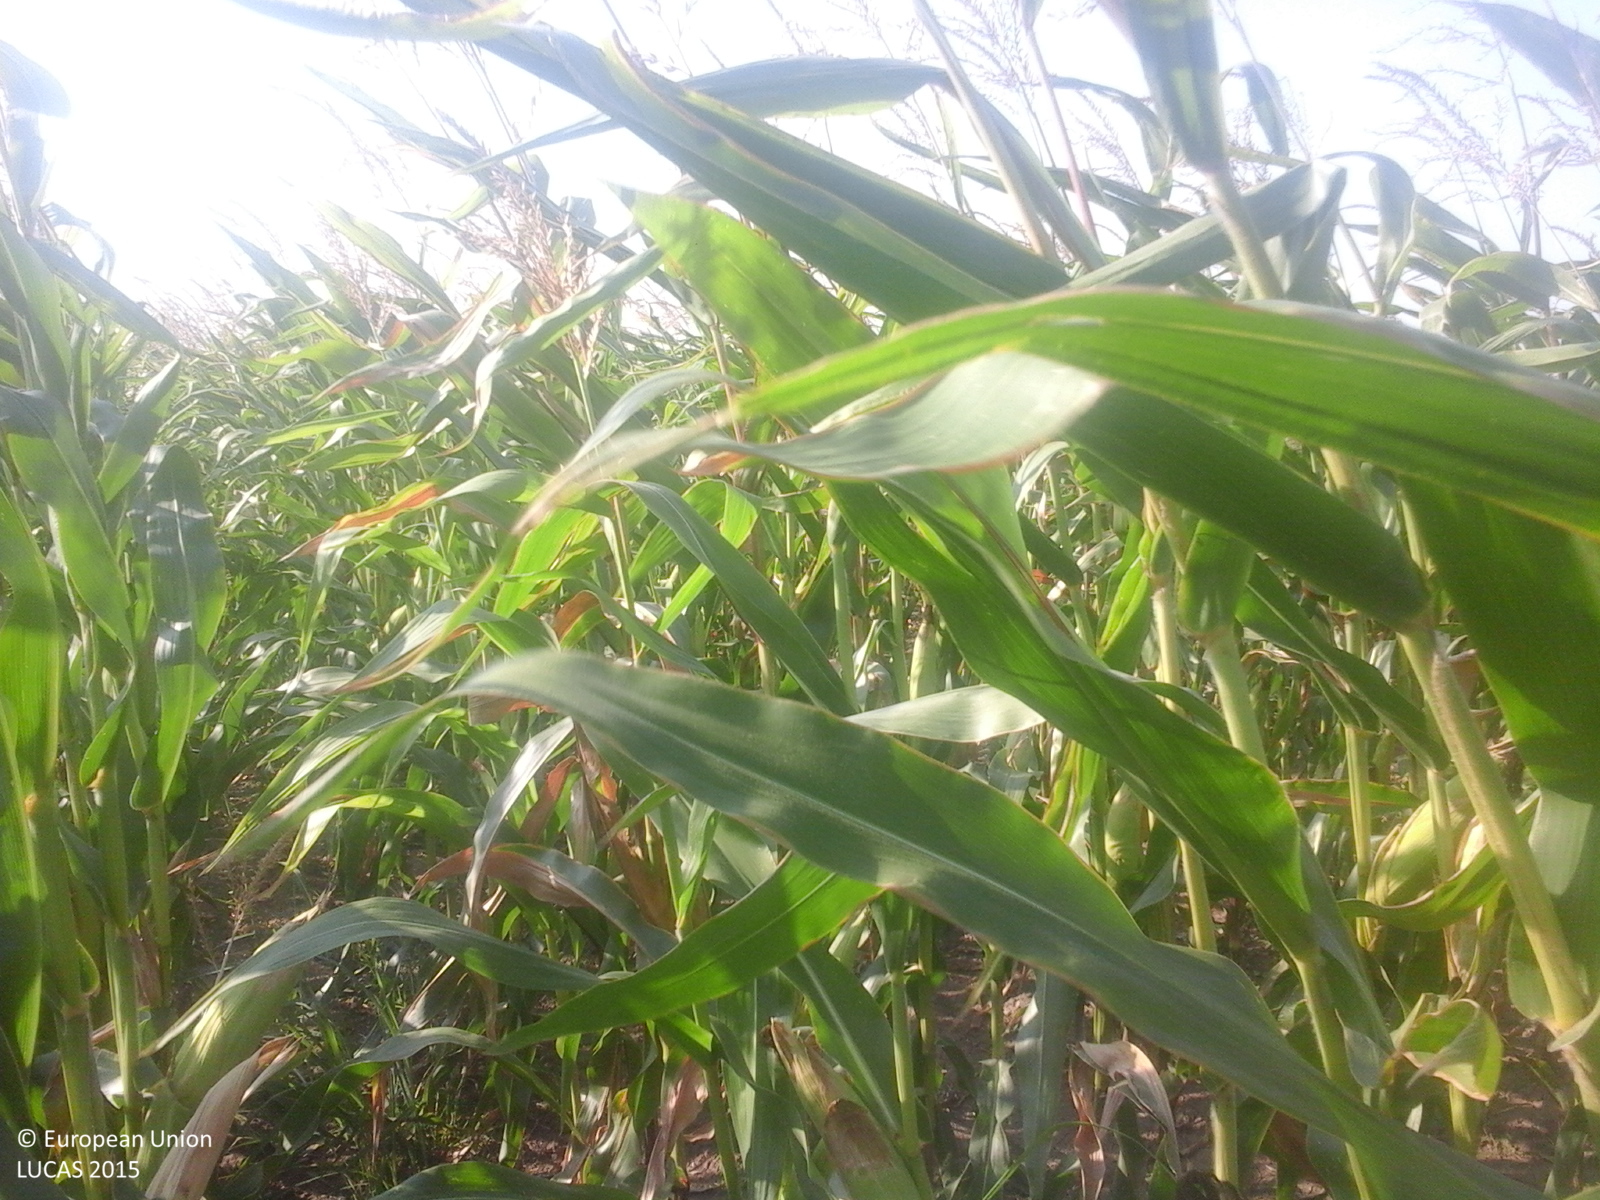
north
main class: Cropland
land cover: Maize
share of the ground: > 75 %
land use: Agriculture (excluding fallow land and kitchen gardens)
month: August
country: RO
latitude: 44.0233
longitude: 28.2626
